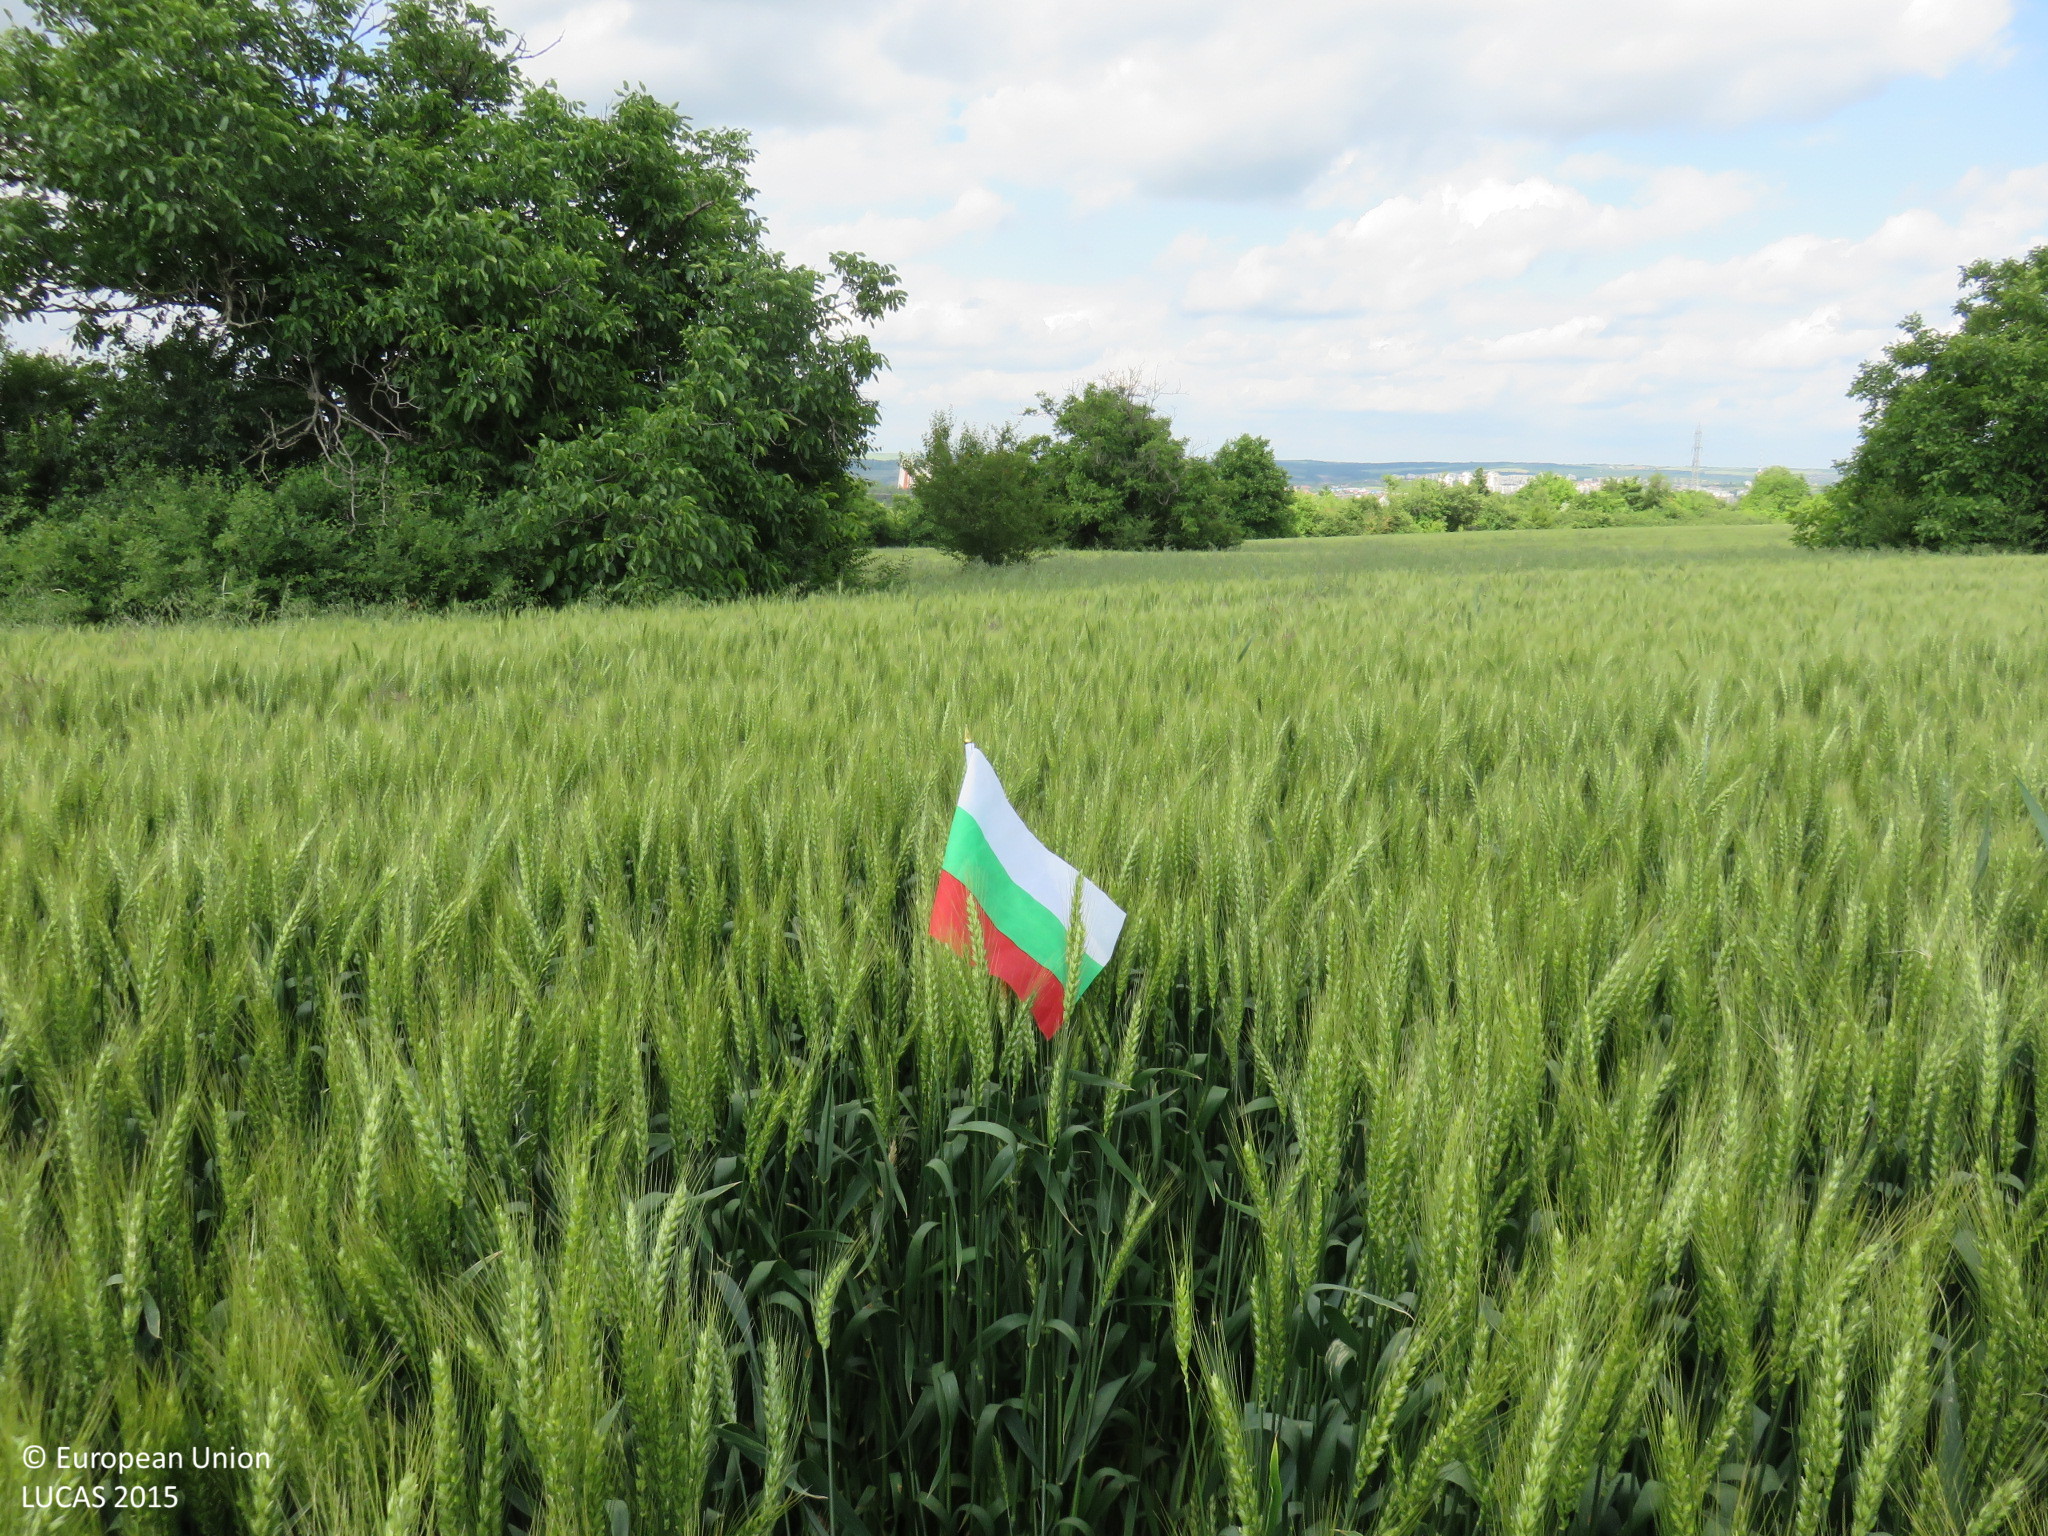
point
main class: Cropland
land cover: Common wheat
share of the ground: > 75 %
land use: Agriculture (excluding fallow land and kitchen gardens)
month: May
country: BG
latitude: 43.3859
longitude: 24.5913
